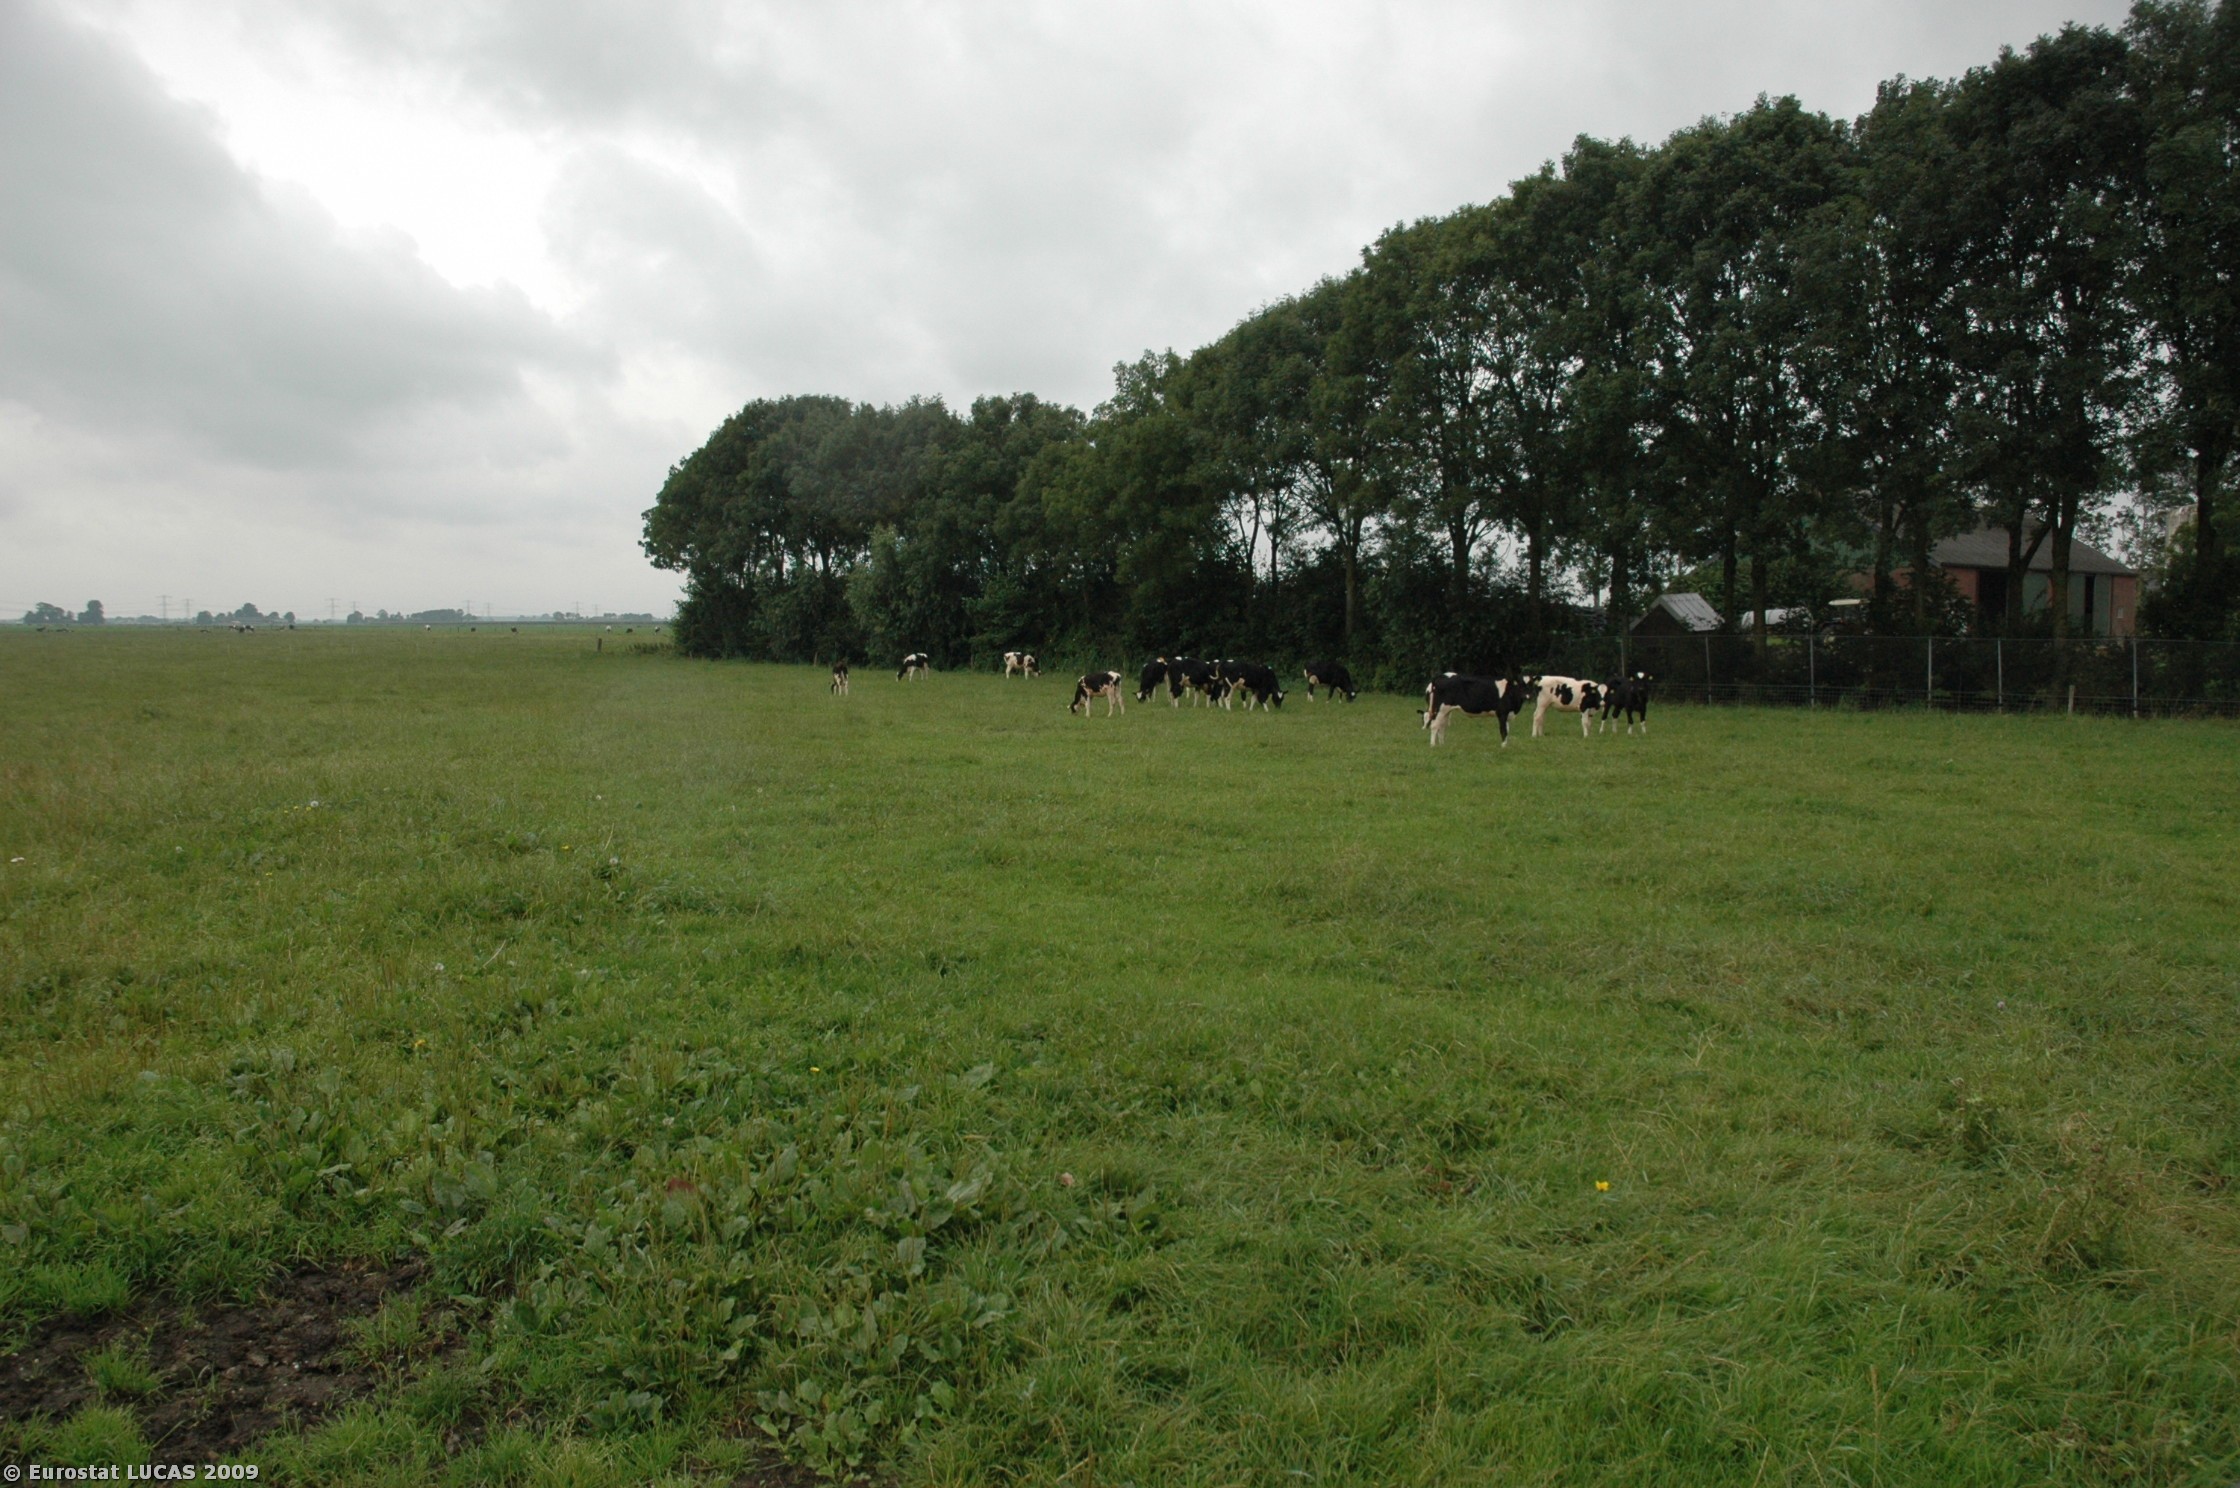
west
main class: Grassland
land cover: Grassland without tree/shrub cover
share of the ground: > 75 %
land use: Agriculture (excluding fallow land and kitchen gardens)
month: August
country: NL
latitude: 52.5641
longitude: 6.0605
